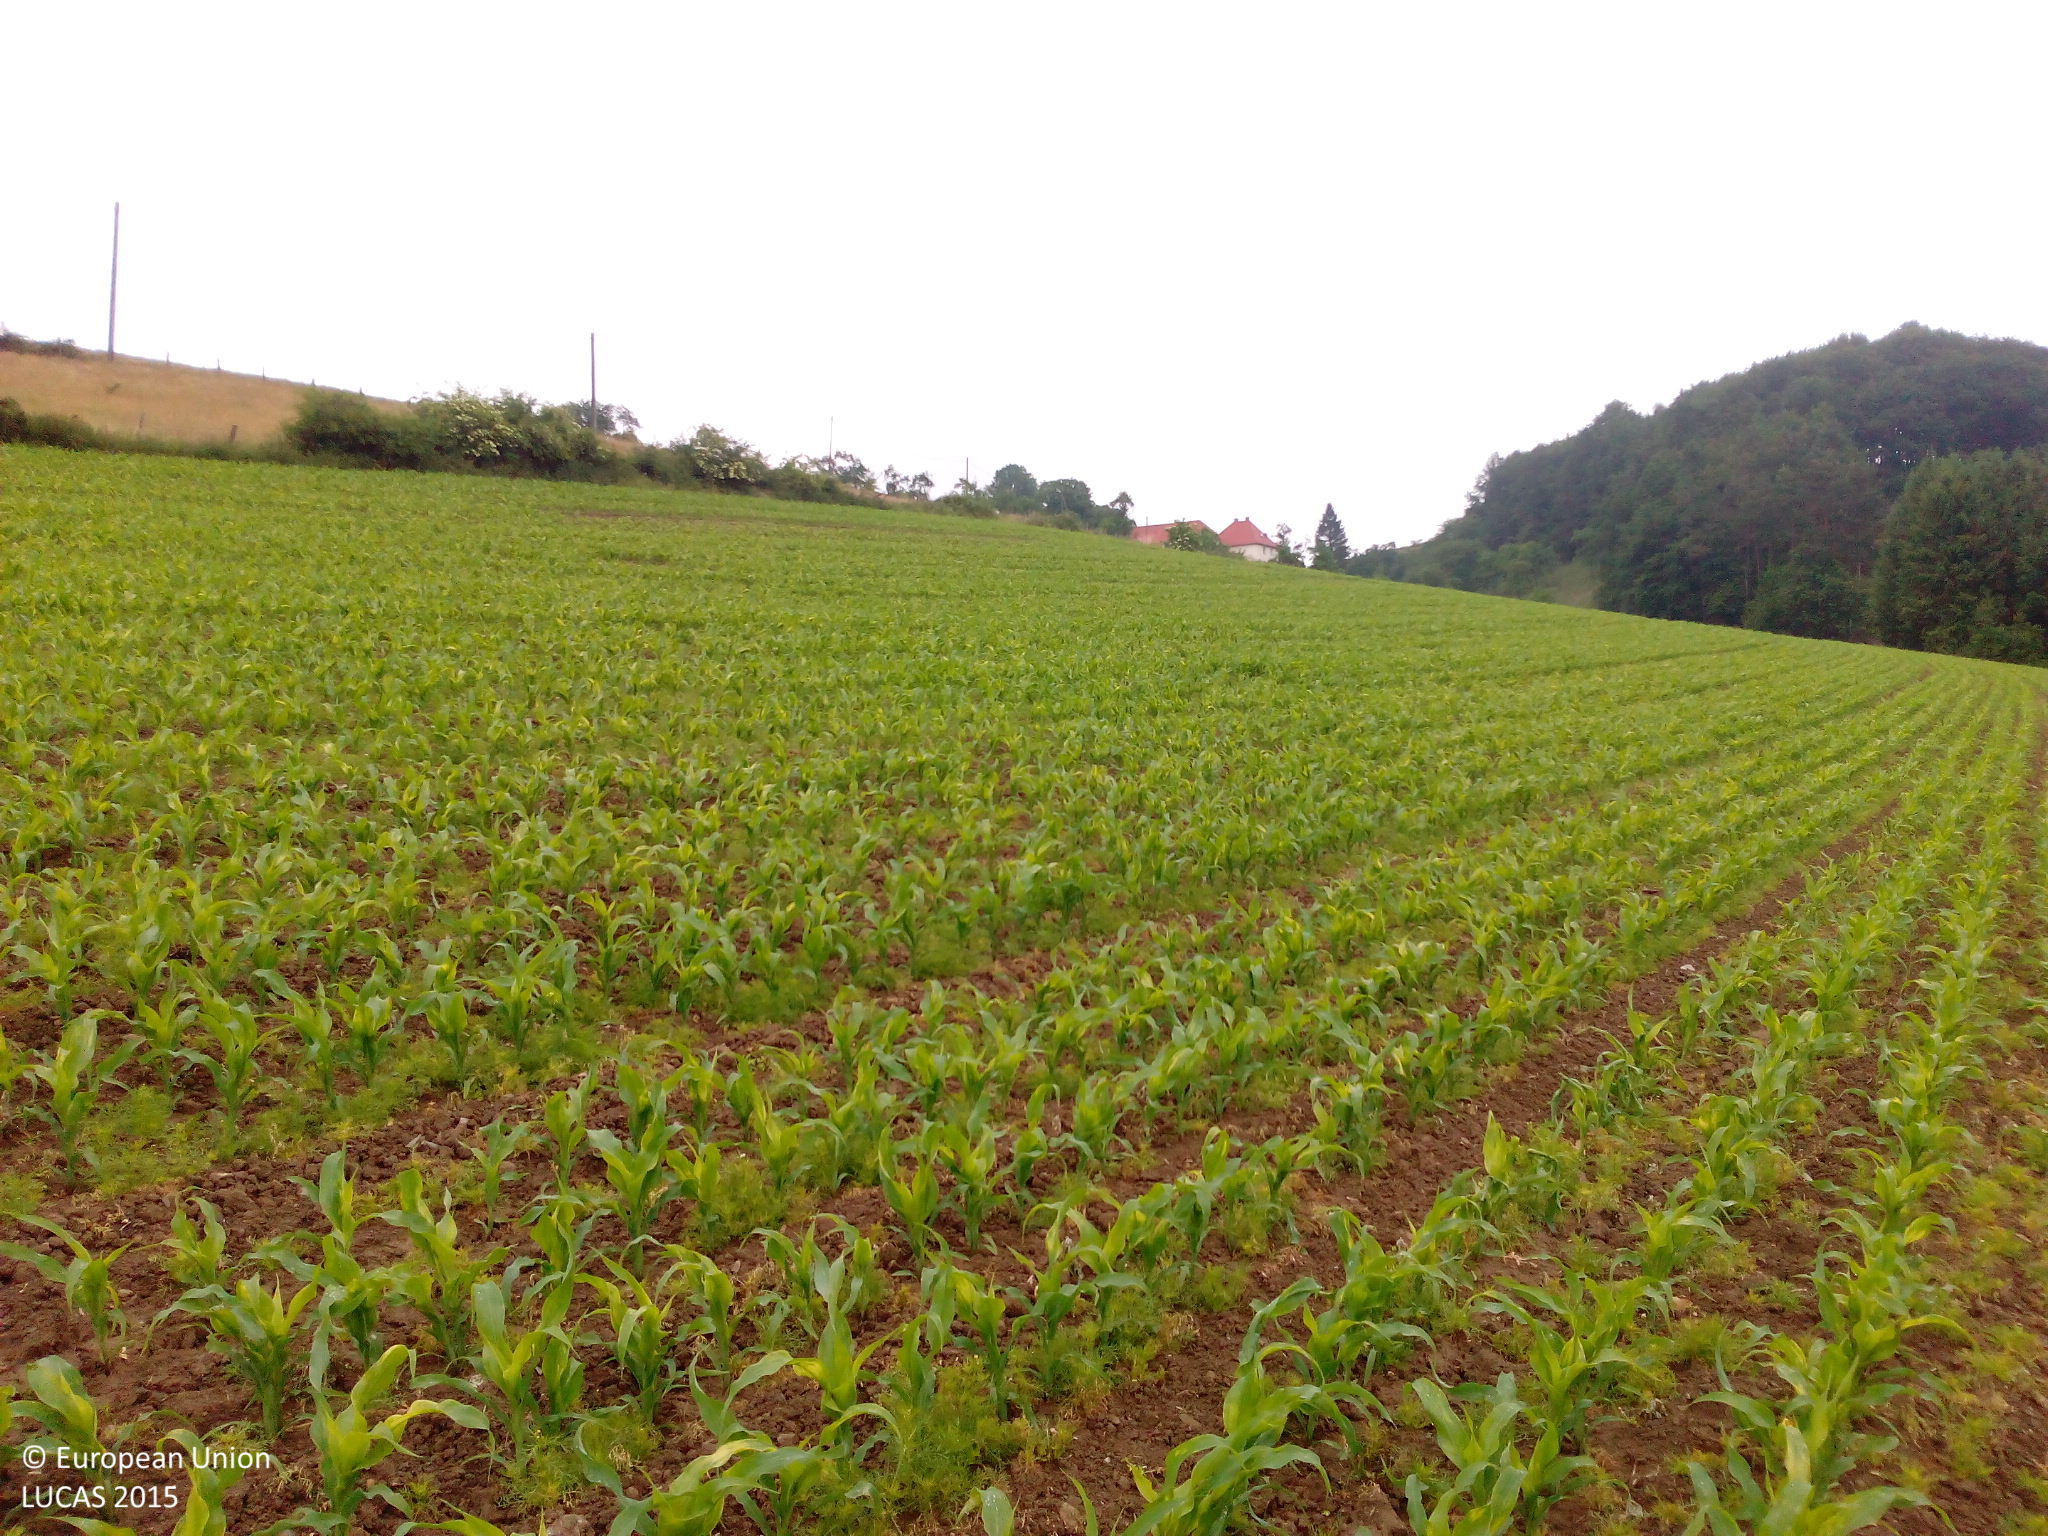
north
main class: Cropland
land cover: Maize
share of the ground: 50 - 75 %
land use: Agriculture (excluding fallow land and kitchen gardens)
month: June
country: DE
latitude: 51.5060
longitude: 8.5740
